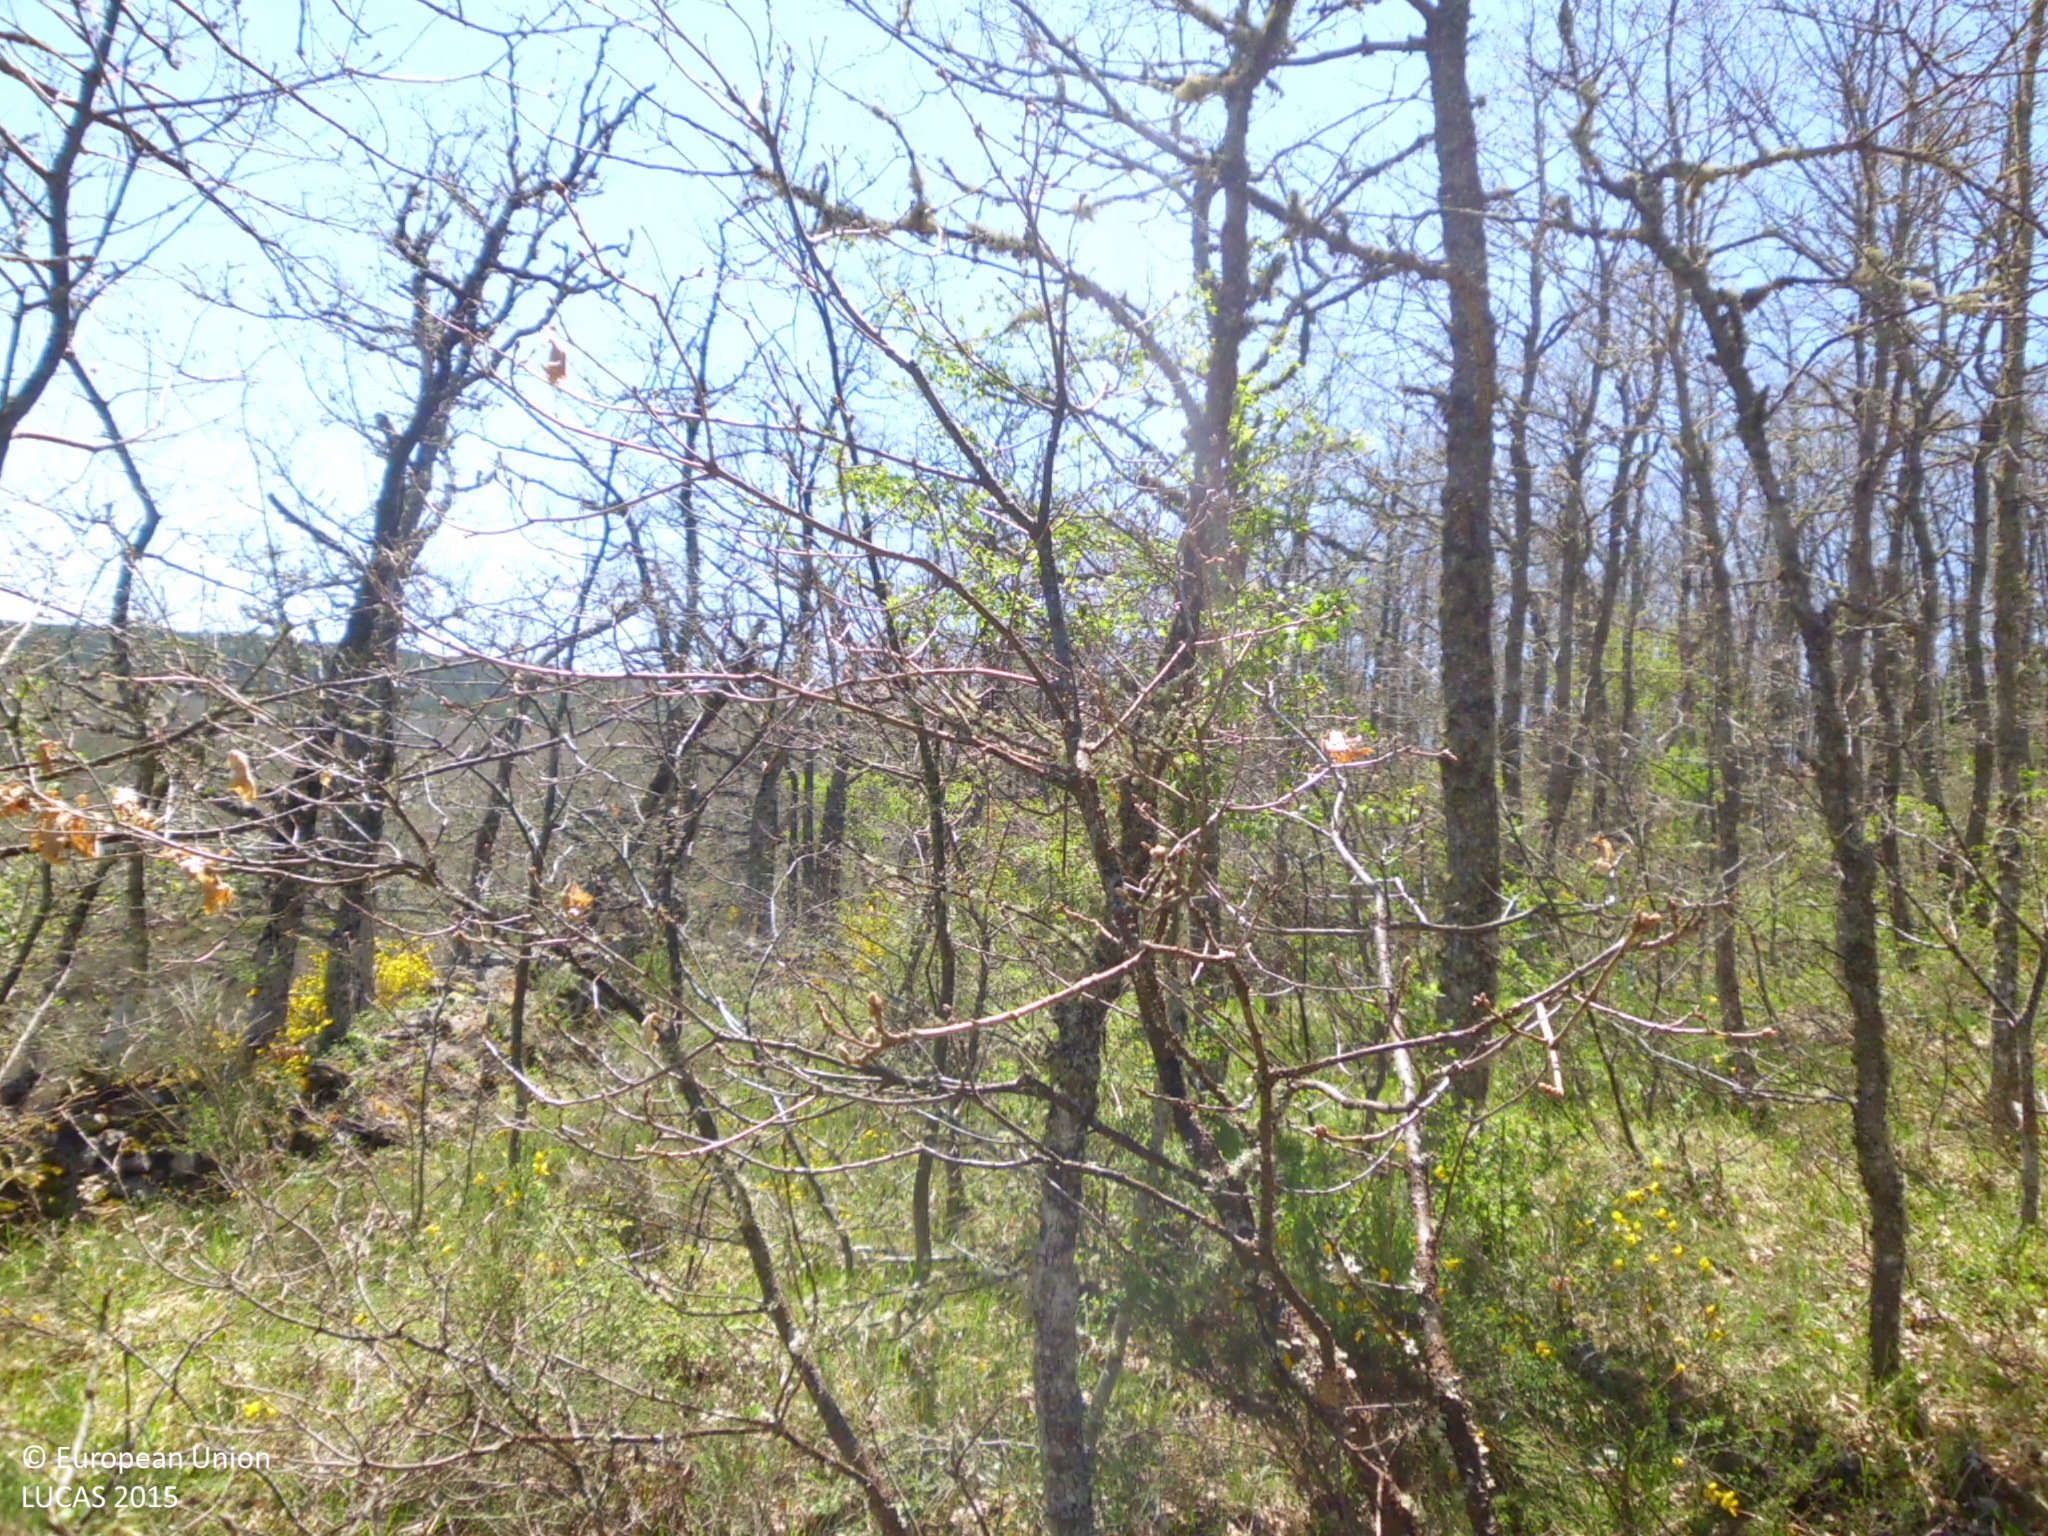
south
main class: Woodland
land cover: Broadleaved woodland
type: acidophilous oak and oak-birch forest
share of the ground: 50 - 75 %
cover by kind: broadleaved forest trees 65 %, herbaceous plants 20 %, shrubs 15 %
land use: Semi-natural and natural areas not in use
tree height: > 5 m
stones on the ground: 25 - 50 %
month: May
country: ES
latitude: 42.8960
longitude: -4.0448
